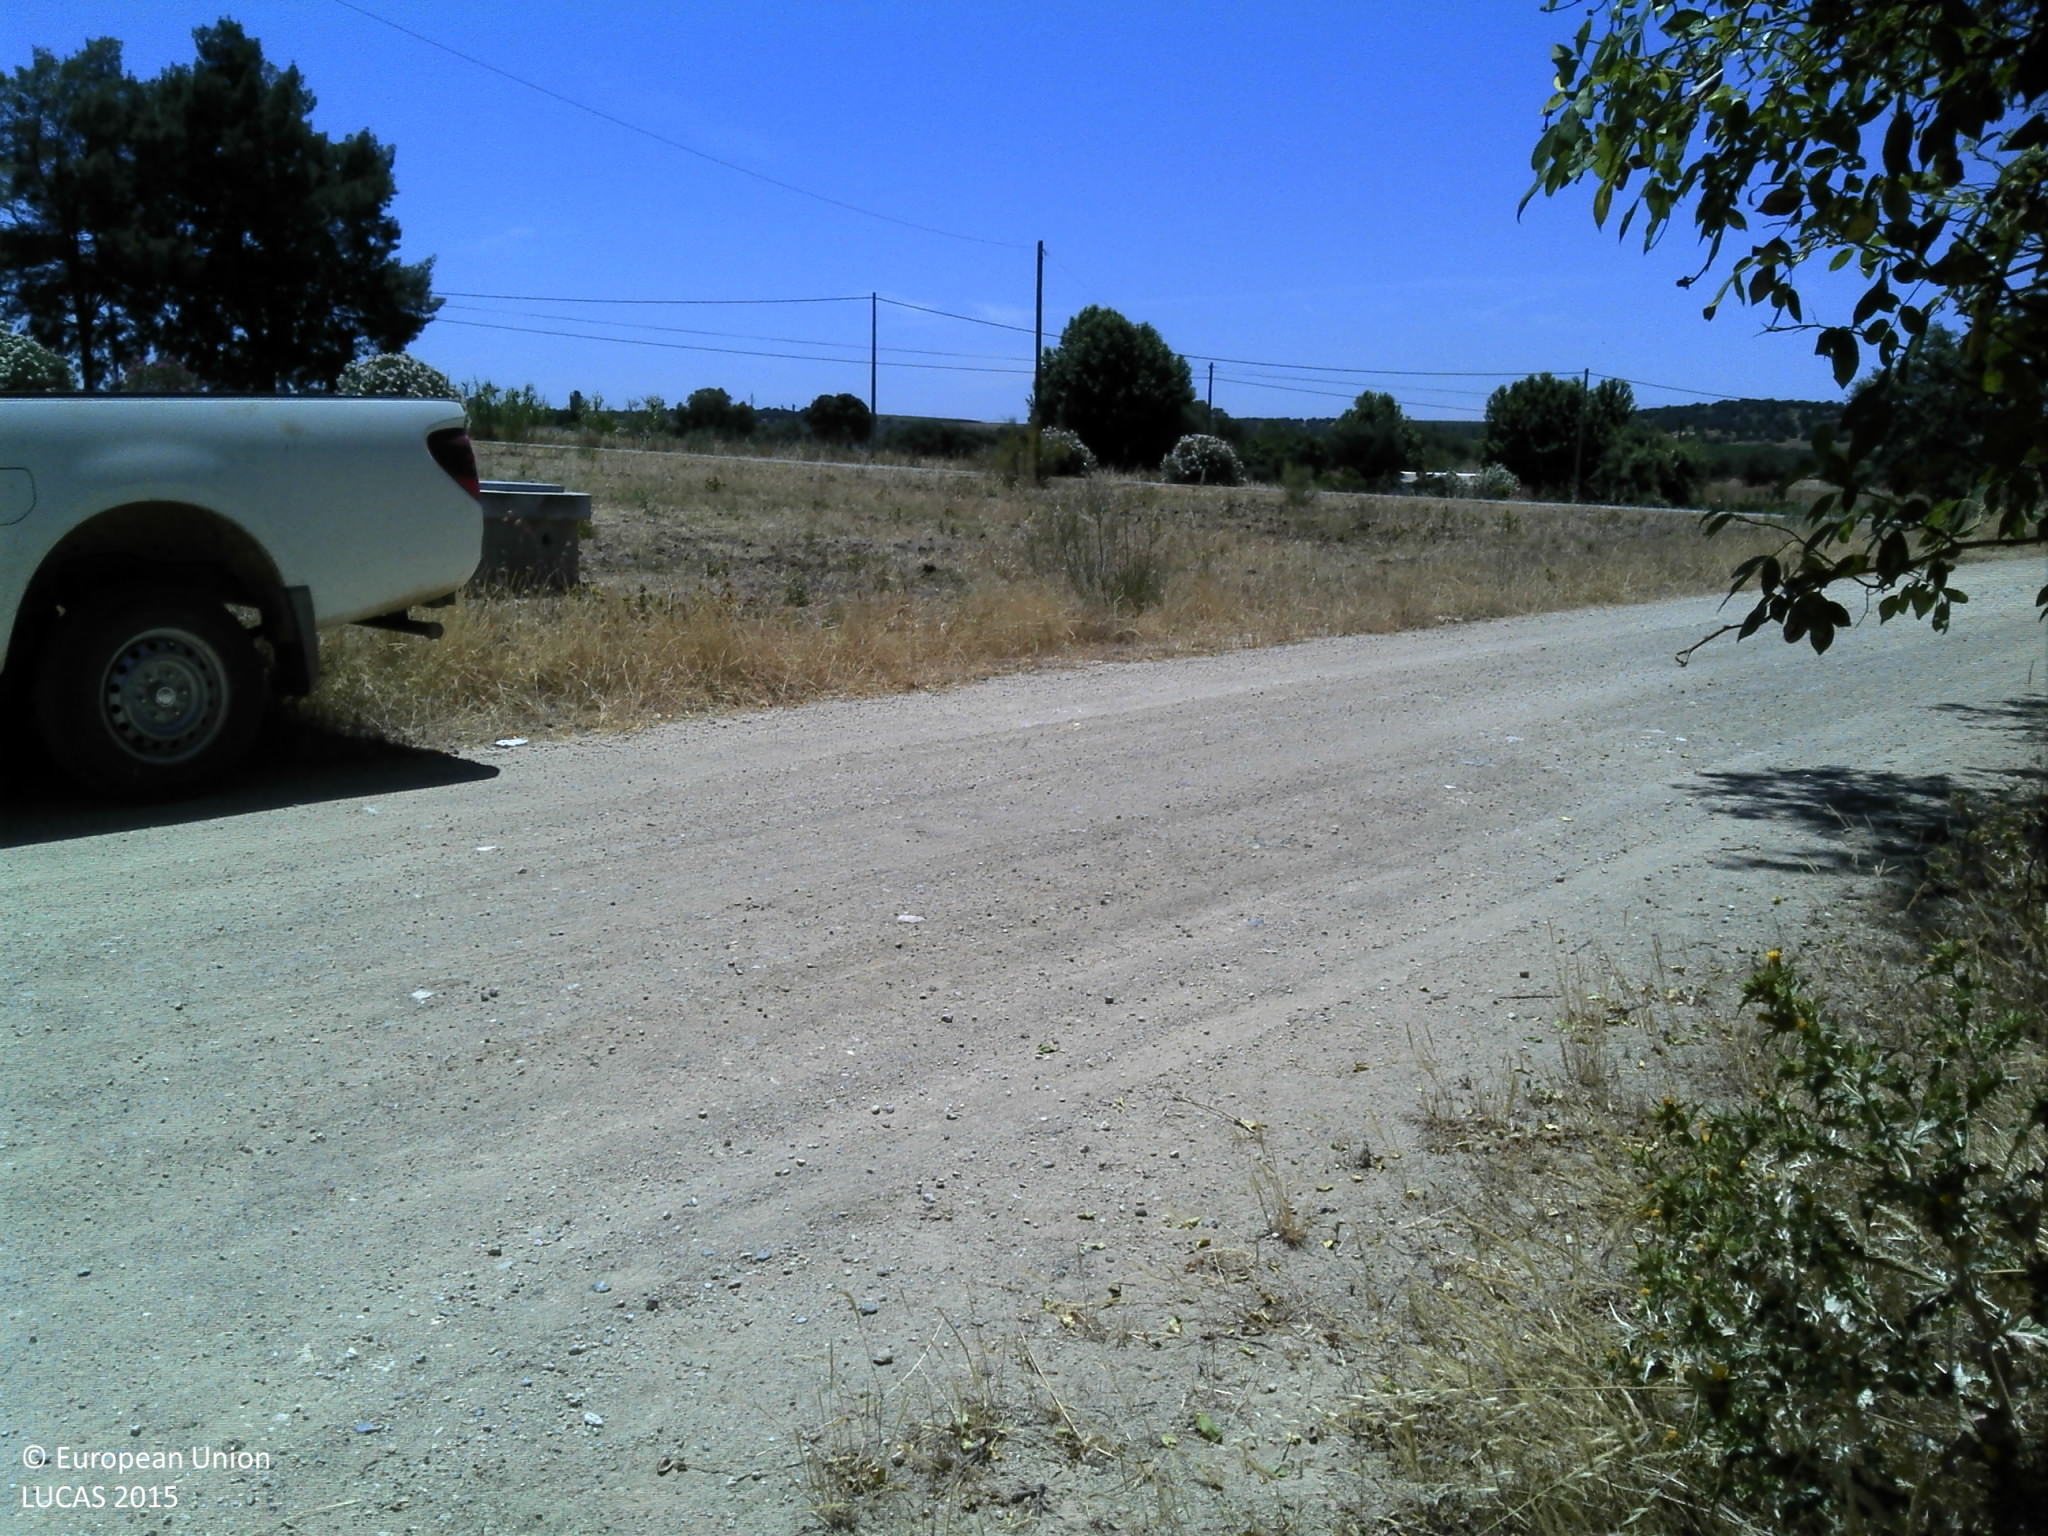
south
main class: Grassland
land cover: Grassland with sparse tree/shrub cover
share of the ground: 25 - 50 %
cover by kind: unconsolidated bare surface 60 %, herbaceous plants 35 %, coniferous forest trees 5 %
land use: Residential
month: June
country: PT
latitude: 37.9279
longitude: -7.5738
